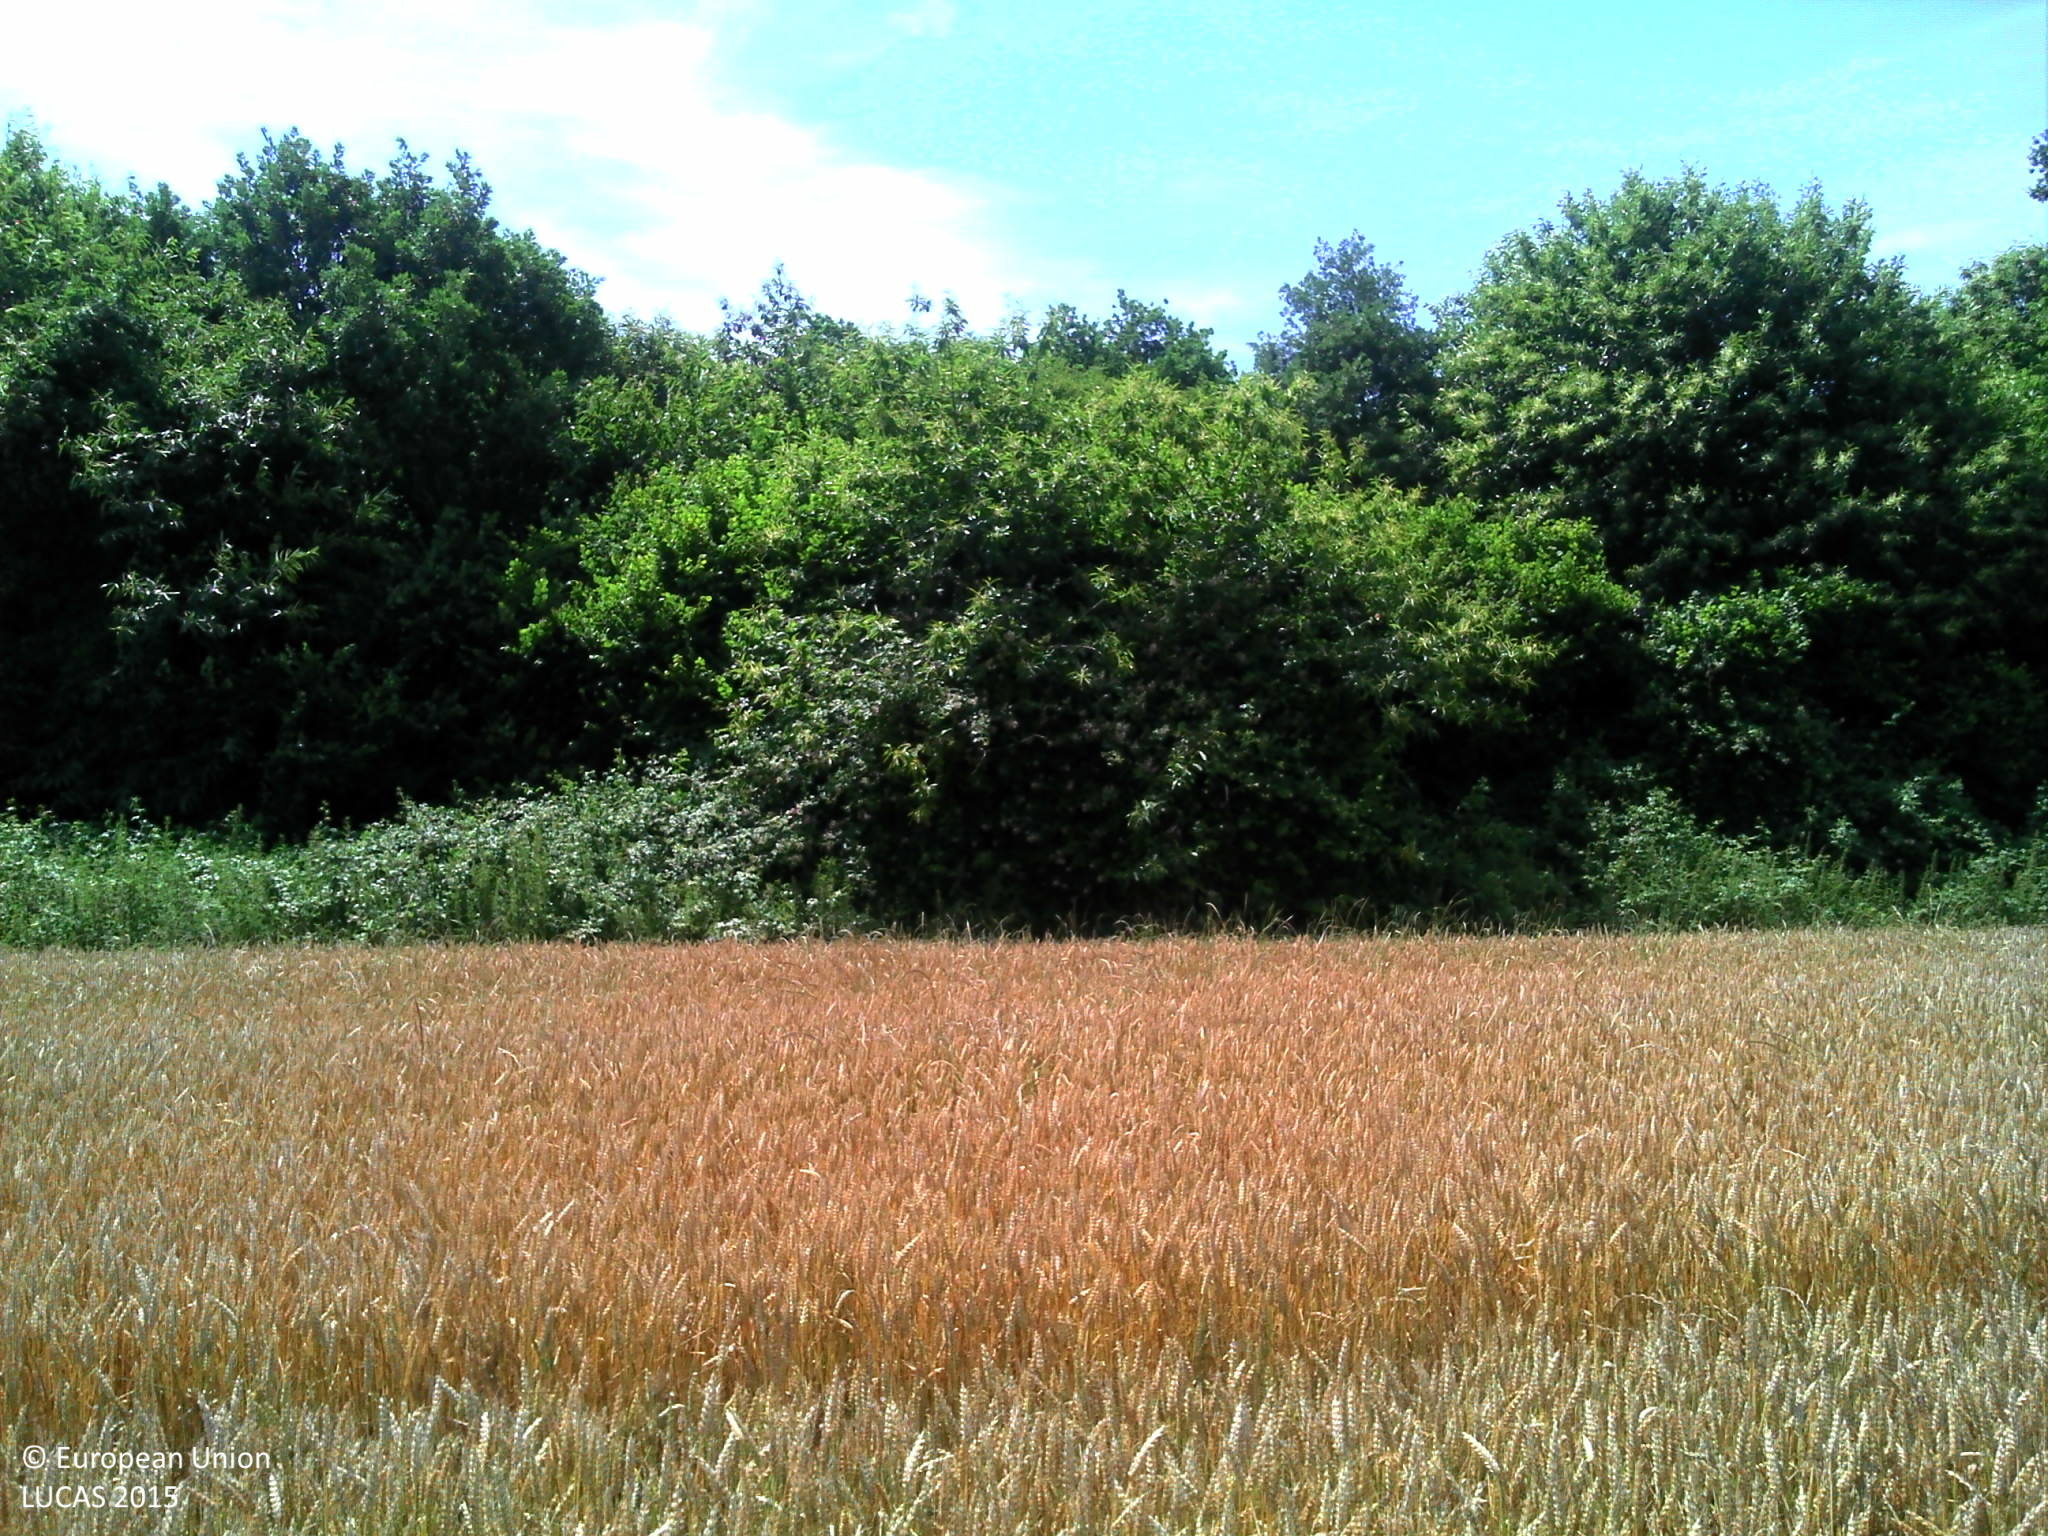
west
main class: Cropland
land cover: Common wheat
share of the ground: > 75 %
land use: Agriculture (excluding fallow land and kitchen gardens)
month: June
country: FR
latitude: 45.7979
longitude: -0.8467
